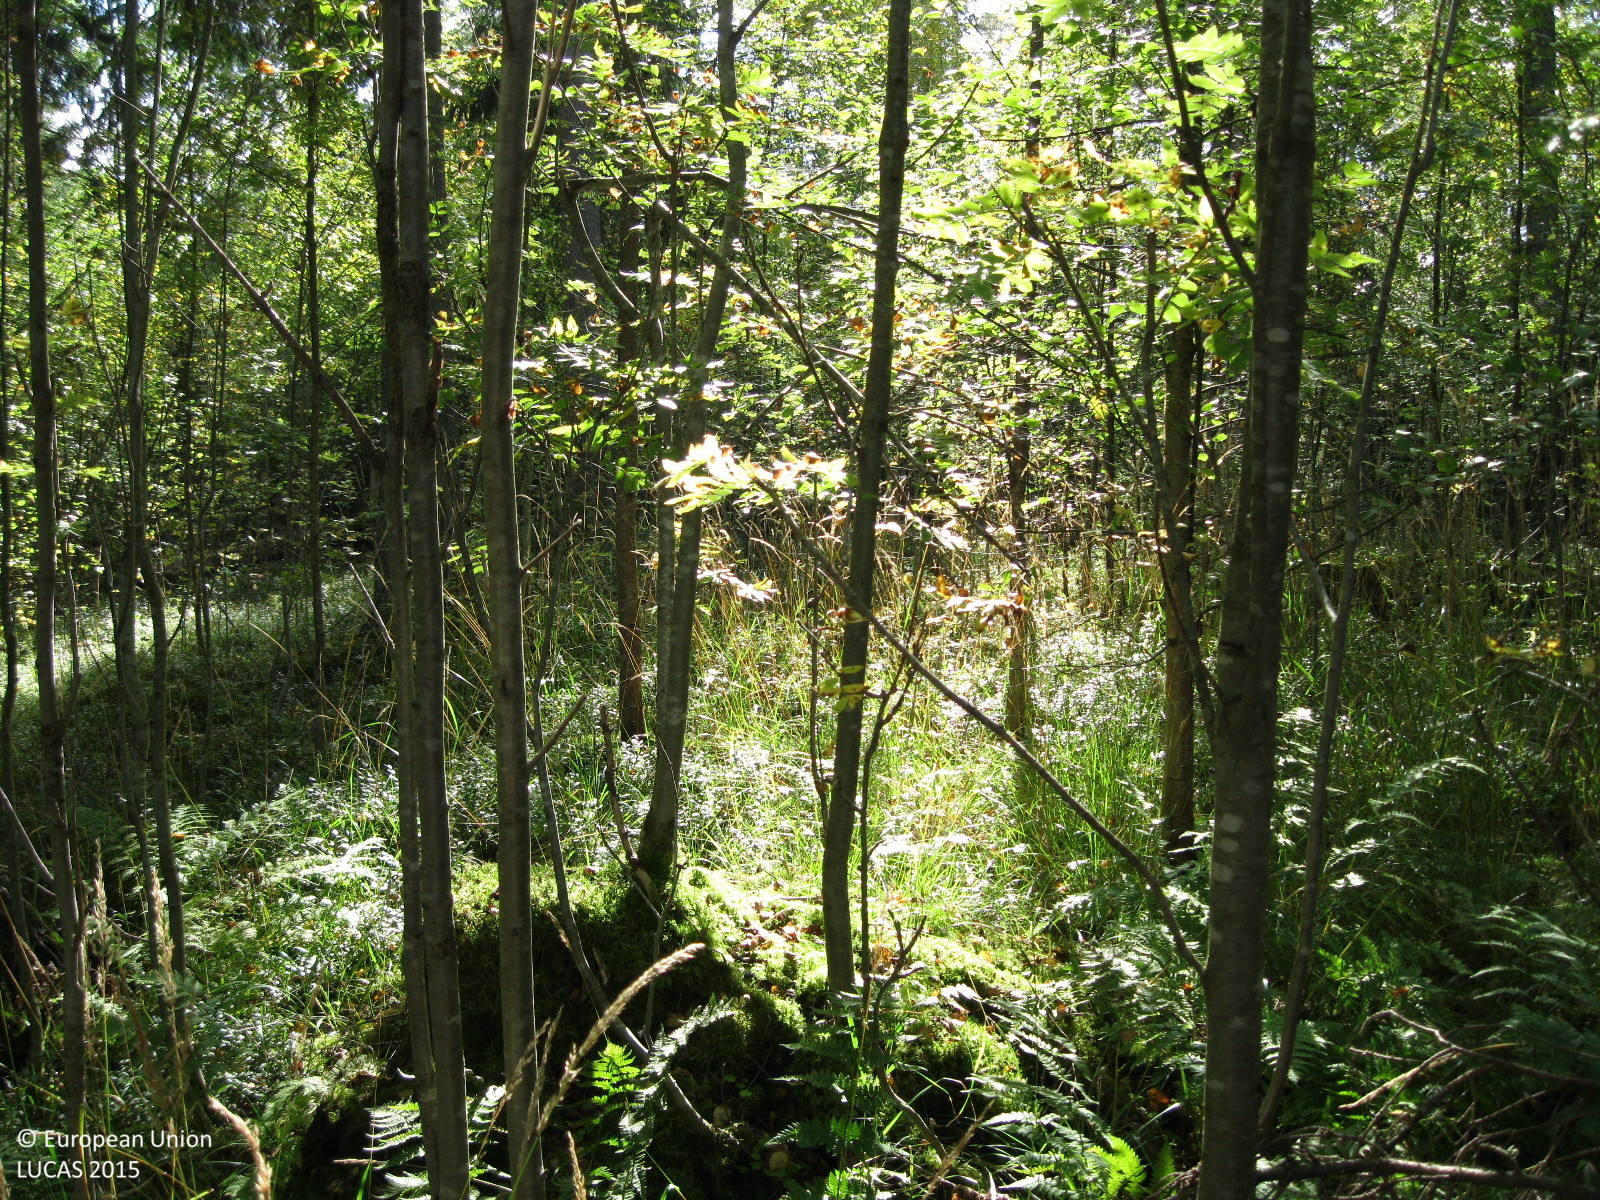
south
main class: Woodland
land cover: Broadleaved woodland
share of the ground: > 75 %
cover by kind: broadleaved forest trees 90 %, shrubs 5 %, herbaceous plants 5 %
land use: Forestry
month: September
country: FI
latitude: 60.3773
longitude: 24.5267
